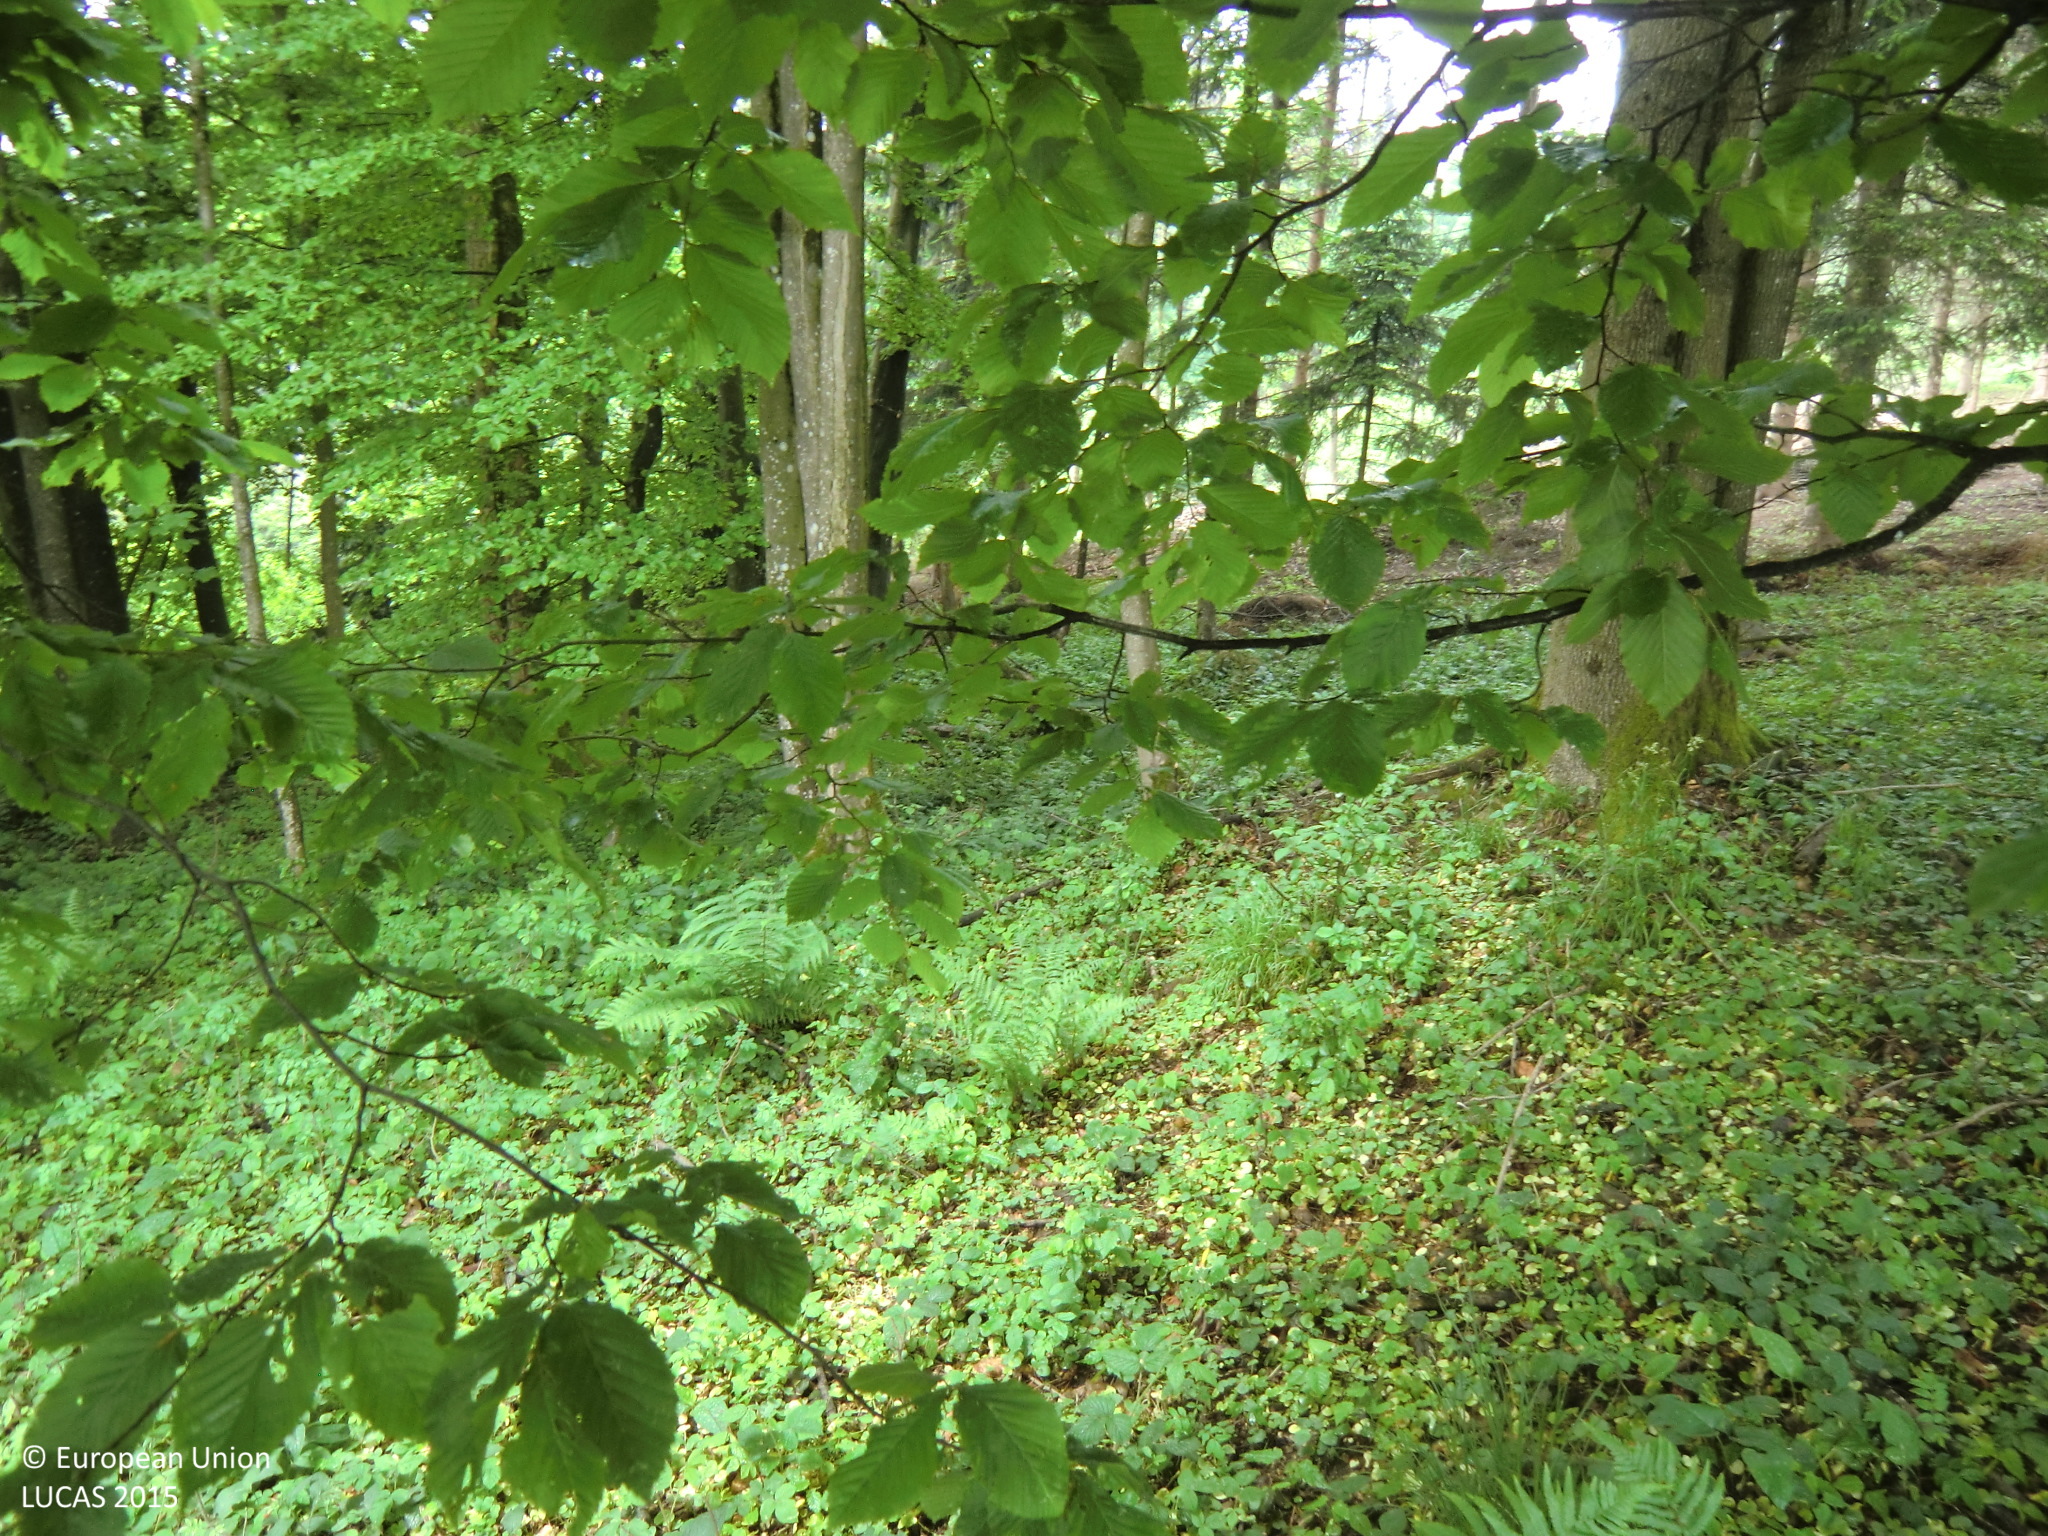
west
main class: Woodland
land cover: Broadleaved woodland
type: hemiboreal forest and nemoral coniferous forest and mixed broadleaved-coniferous forest
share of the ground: > 75 %
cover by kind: broadleaved forest trees 75 %, herbaceous plants 20 %, unconsolidated bare surface 5 %
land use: Forestry
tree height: > 5 m
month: May
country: AT
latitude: 48.3557
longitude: 14.3053
